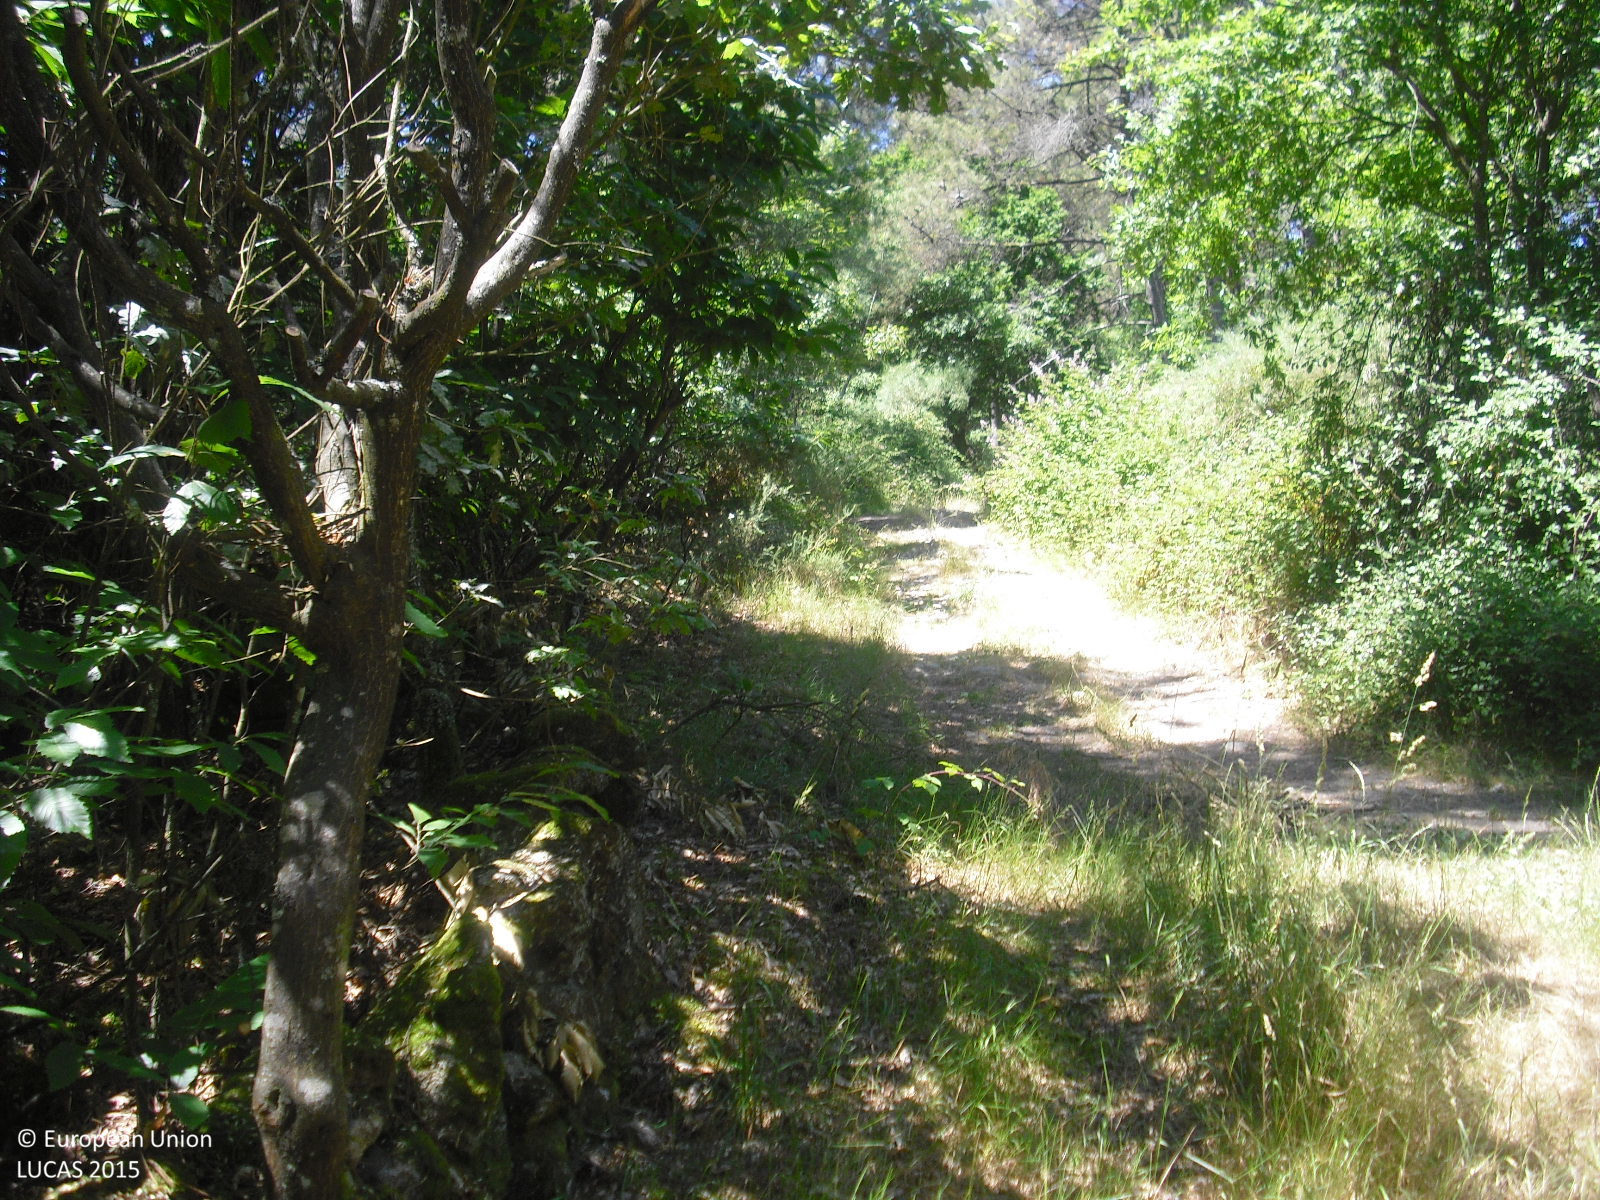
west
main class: Woodland
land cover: Pine dominated mixed woodland
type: hemiboreal forest and nemoral coniferous forest and mixed broadleaved-coniferous forest
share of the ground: 50 - 75 %
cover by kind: coniferous forest trees 50 %, shrubs 30 %, broadleaved forest trees 20 %
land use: Semi-natural and natural areas not in use
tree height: > 5 m
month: June
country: ES
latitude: 42.5221
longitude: -7.8891
